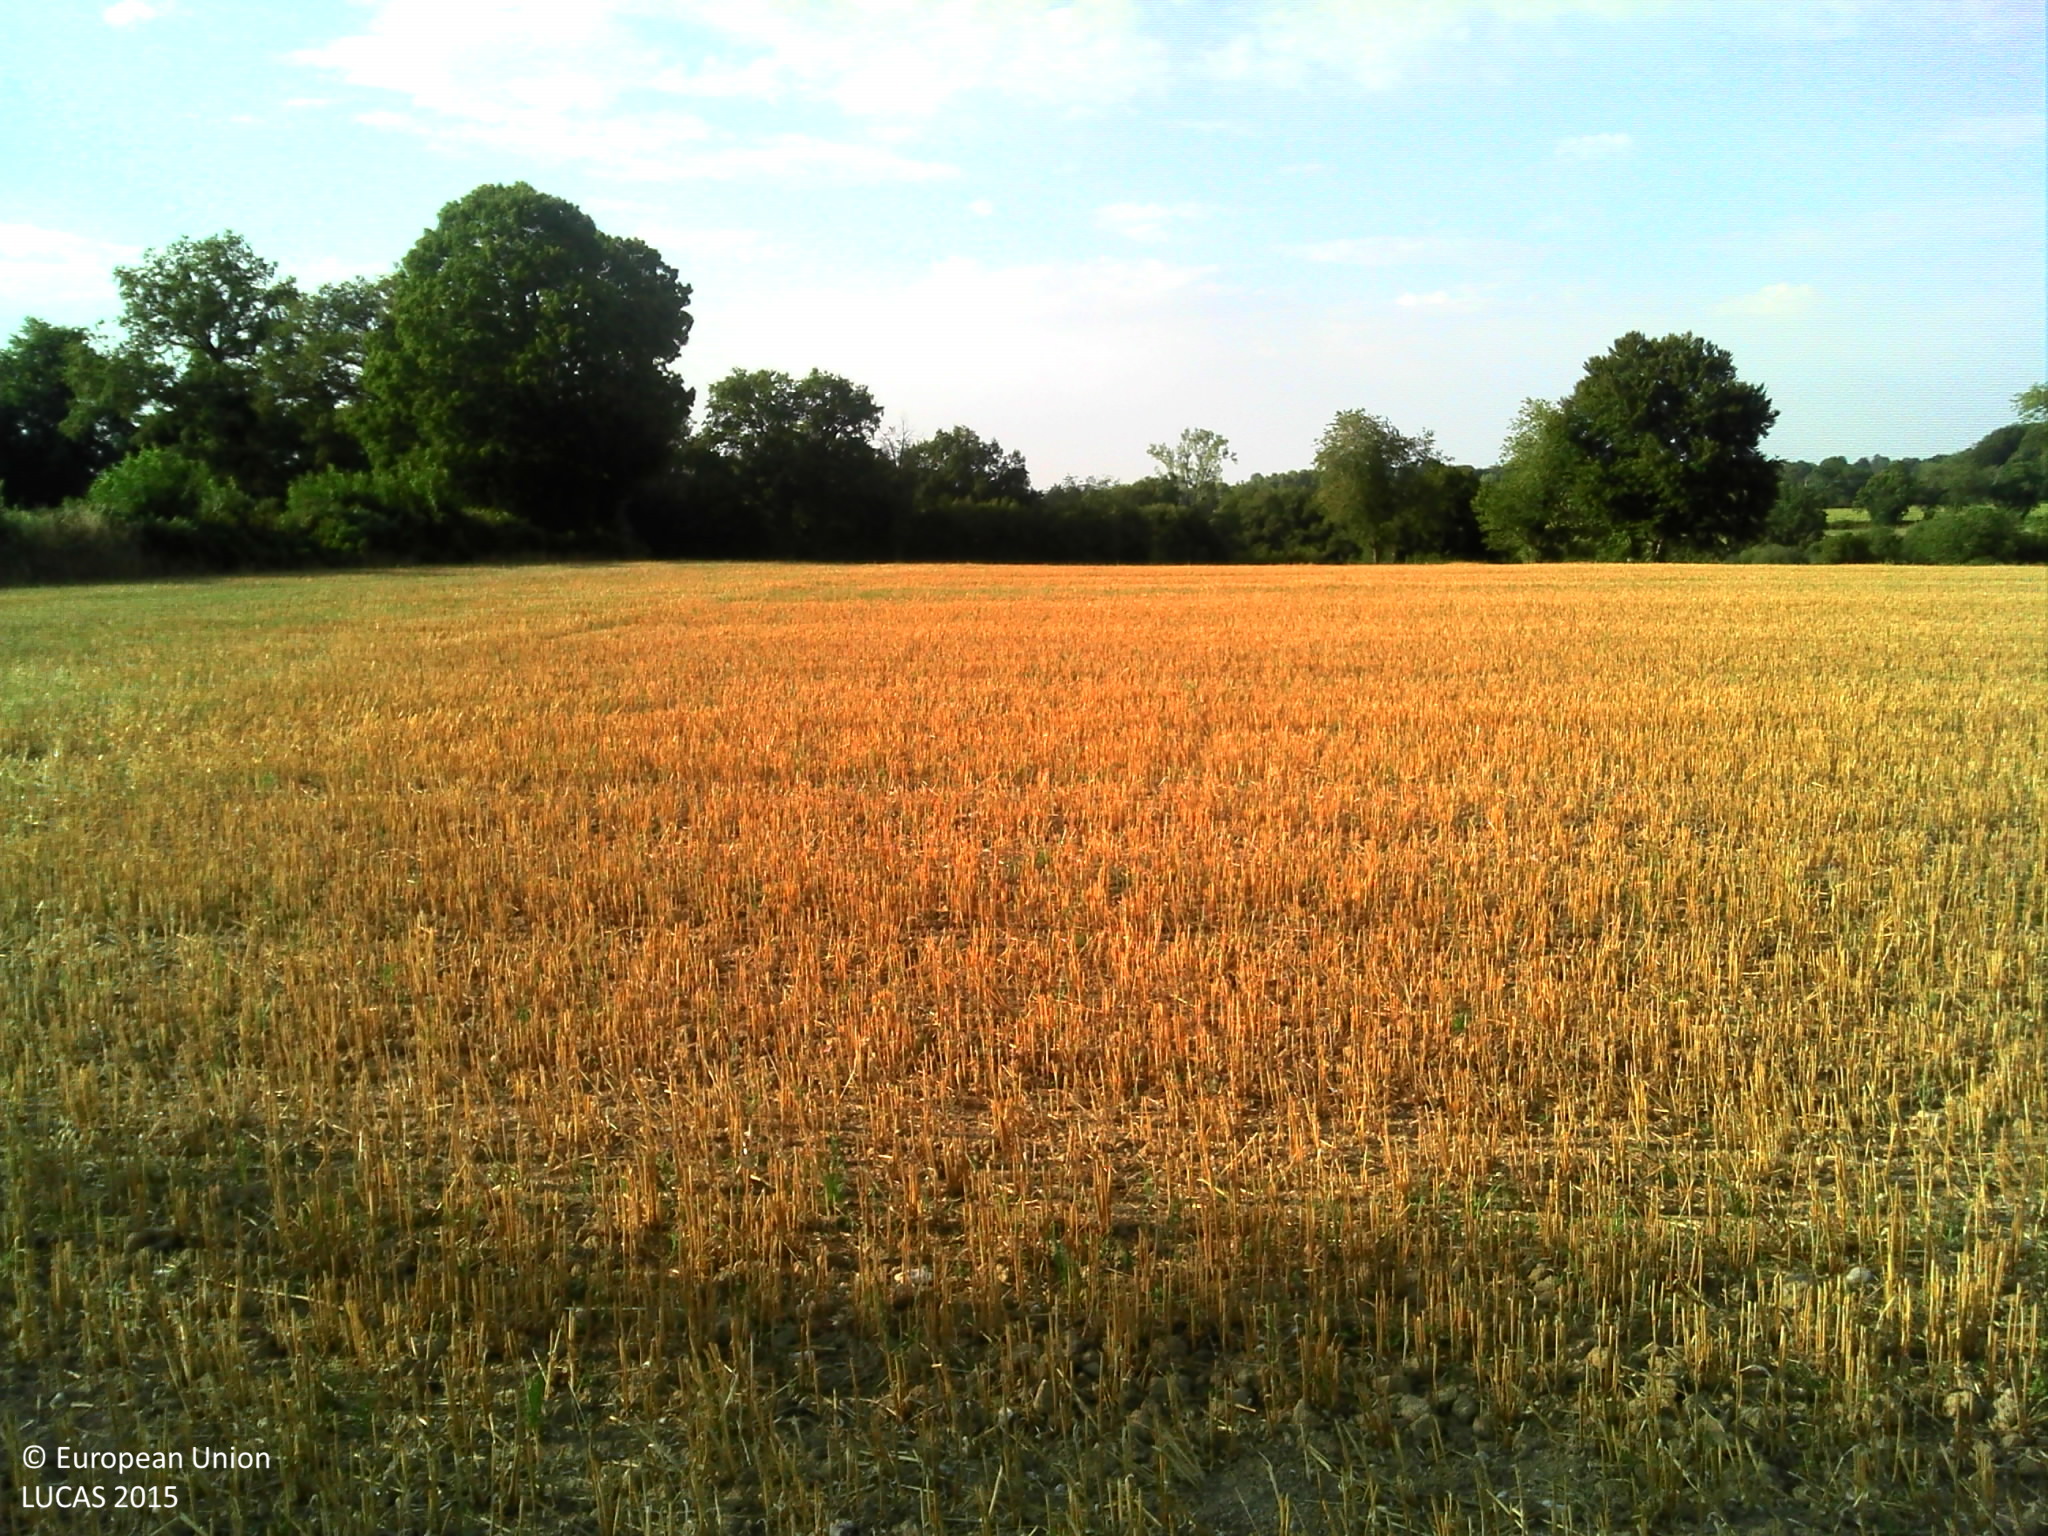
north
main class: Cropland
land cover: Oats
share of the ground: > 75 %
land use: Agriculture (excluding fallow land and kitchen gardens)
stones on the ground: 10 - 25 %
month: August
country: FR
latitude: 46.3939
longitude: 2.2301
